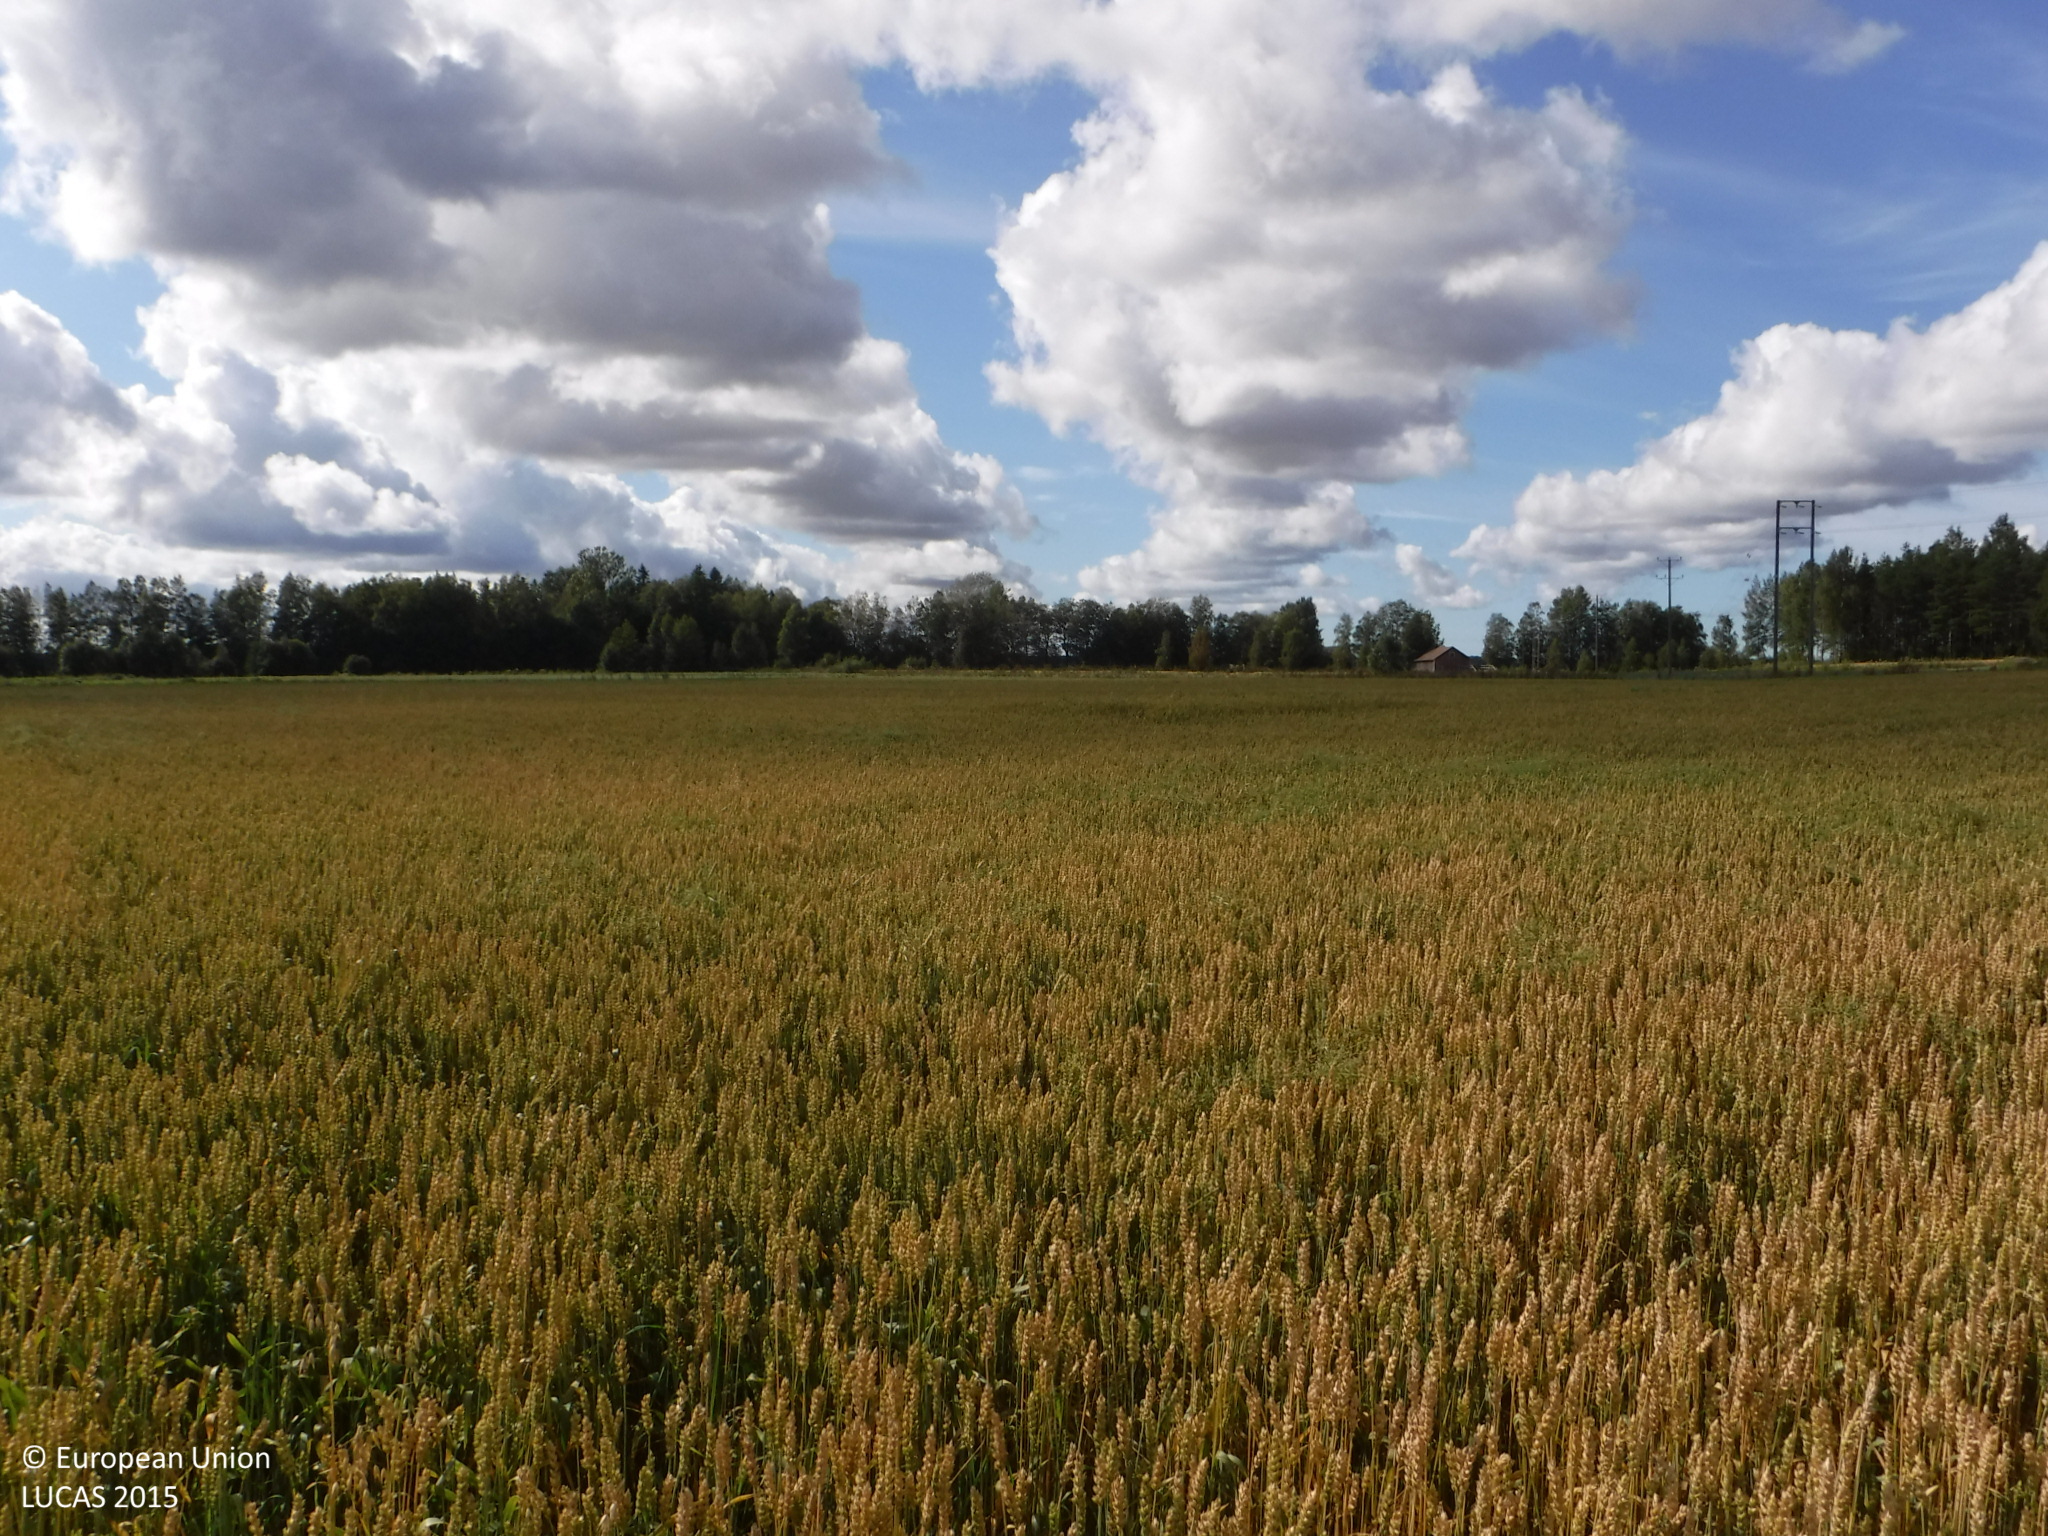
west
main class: Cropland
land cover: Common wheat
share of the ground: > 75 %
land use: Agriculture (excluding fallow land and kitchen gardens)
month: August
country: FI
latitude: 61.2239
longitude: 21.9196
